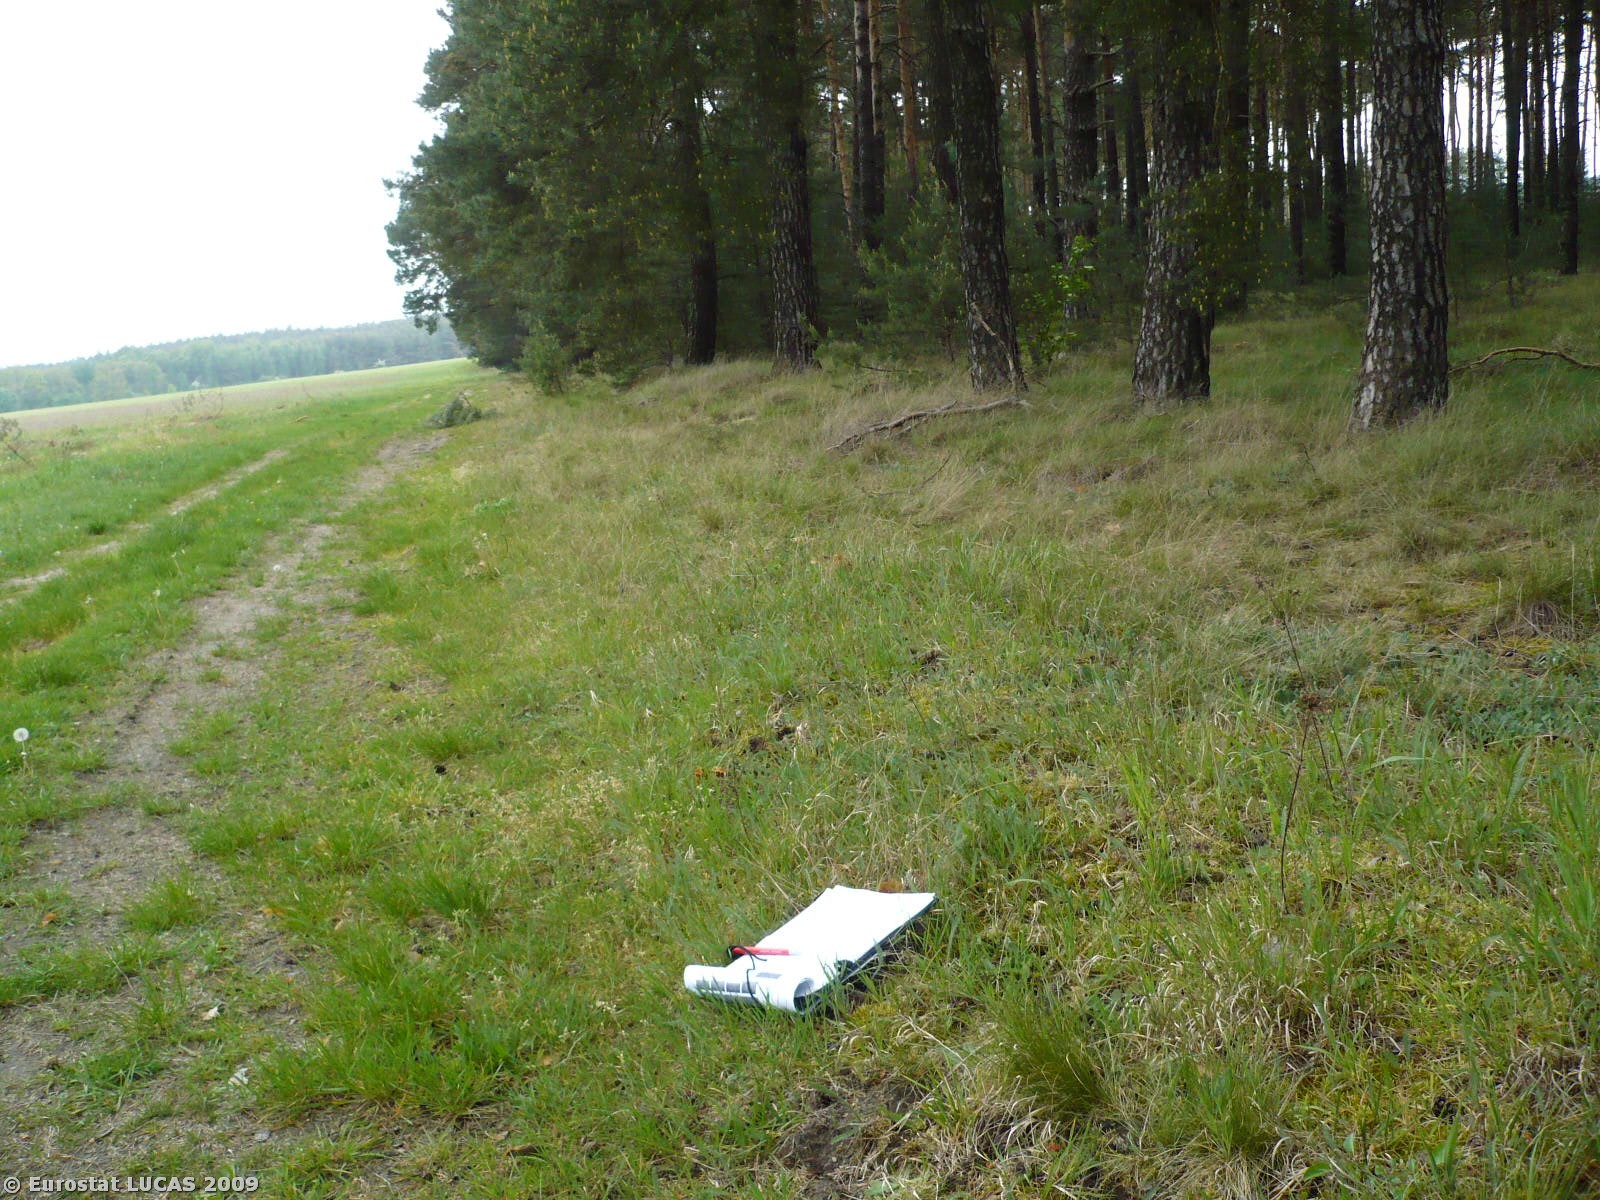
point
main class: Woodland
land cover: Coniferous woodland
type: hemiboreal forest and nemoral coniferous forest and mixed broadleaved-coniferous forest
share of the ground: > 75 %
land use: Forestry
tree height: > 5 m
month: May
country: PL
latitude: 51.9267
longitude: 15.0782
